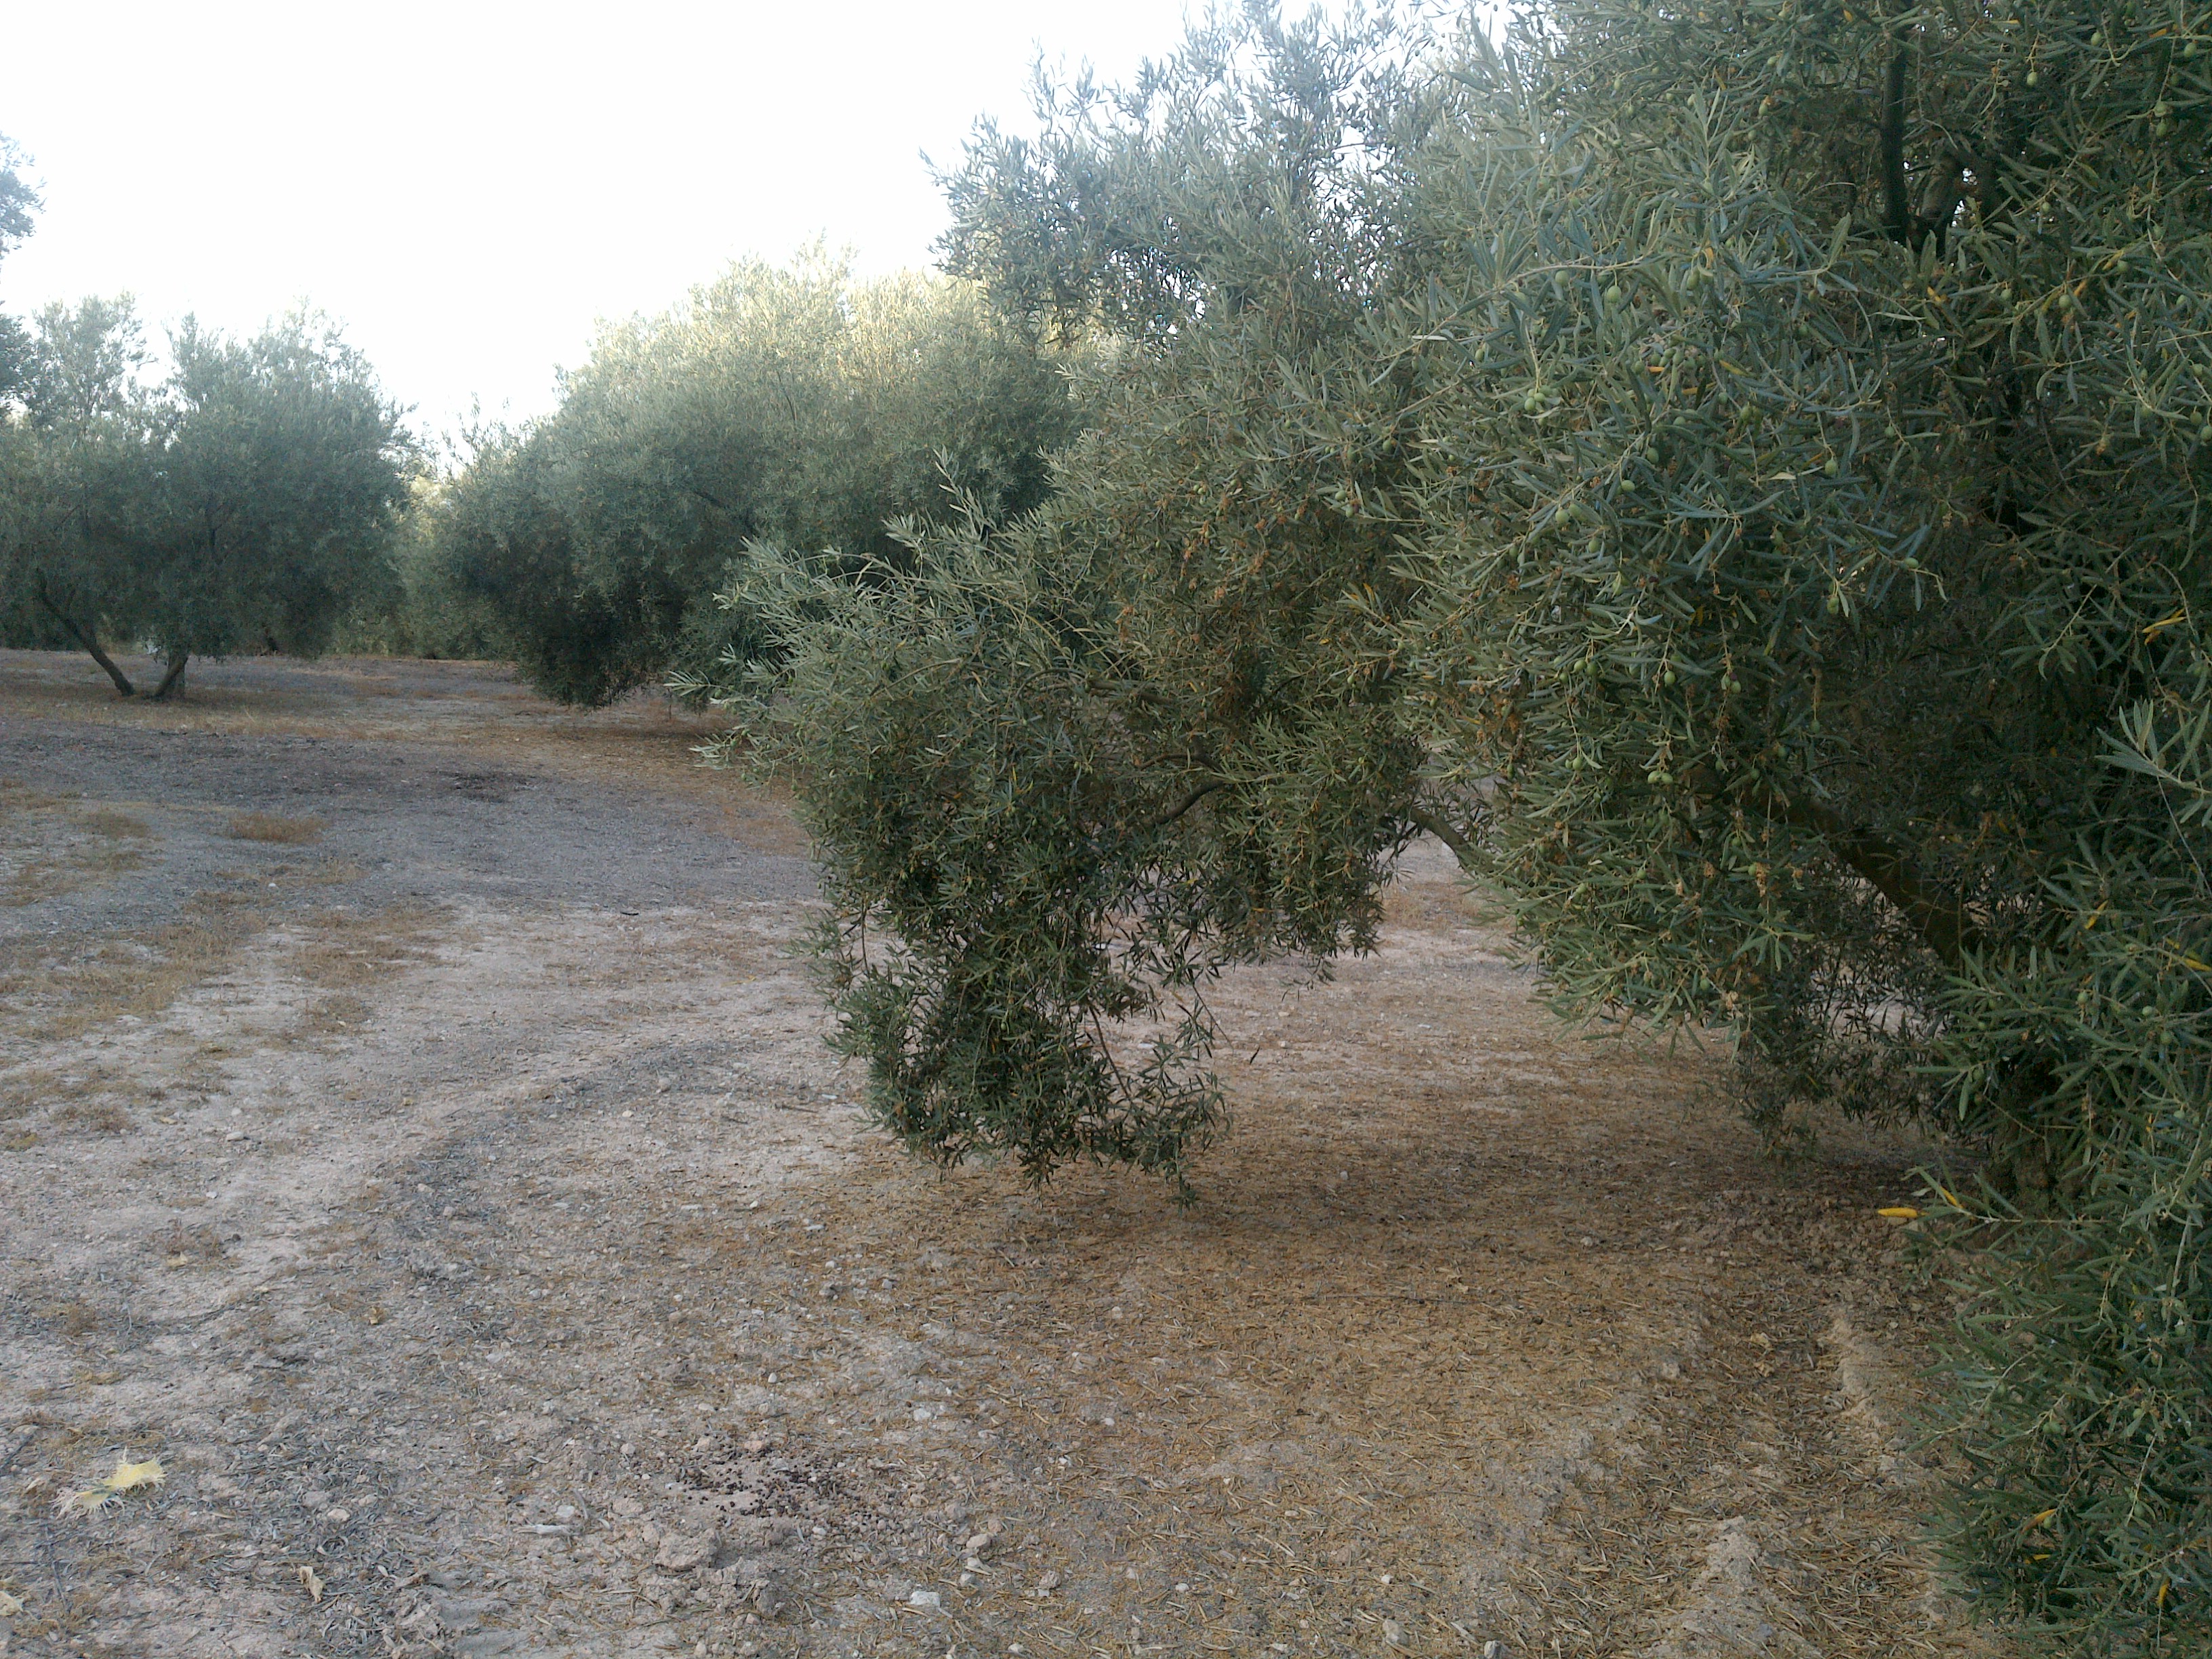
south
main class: Cropland
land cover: Olive groves
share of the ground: 50 - 75 %
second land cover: Spontaneously vegetated surfaces
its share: 10 - 25 %
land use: Agriculture (excluding fallow land and kitchen gardens)
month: July
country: ES
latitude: 37.3807
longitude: -4.4004
